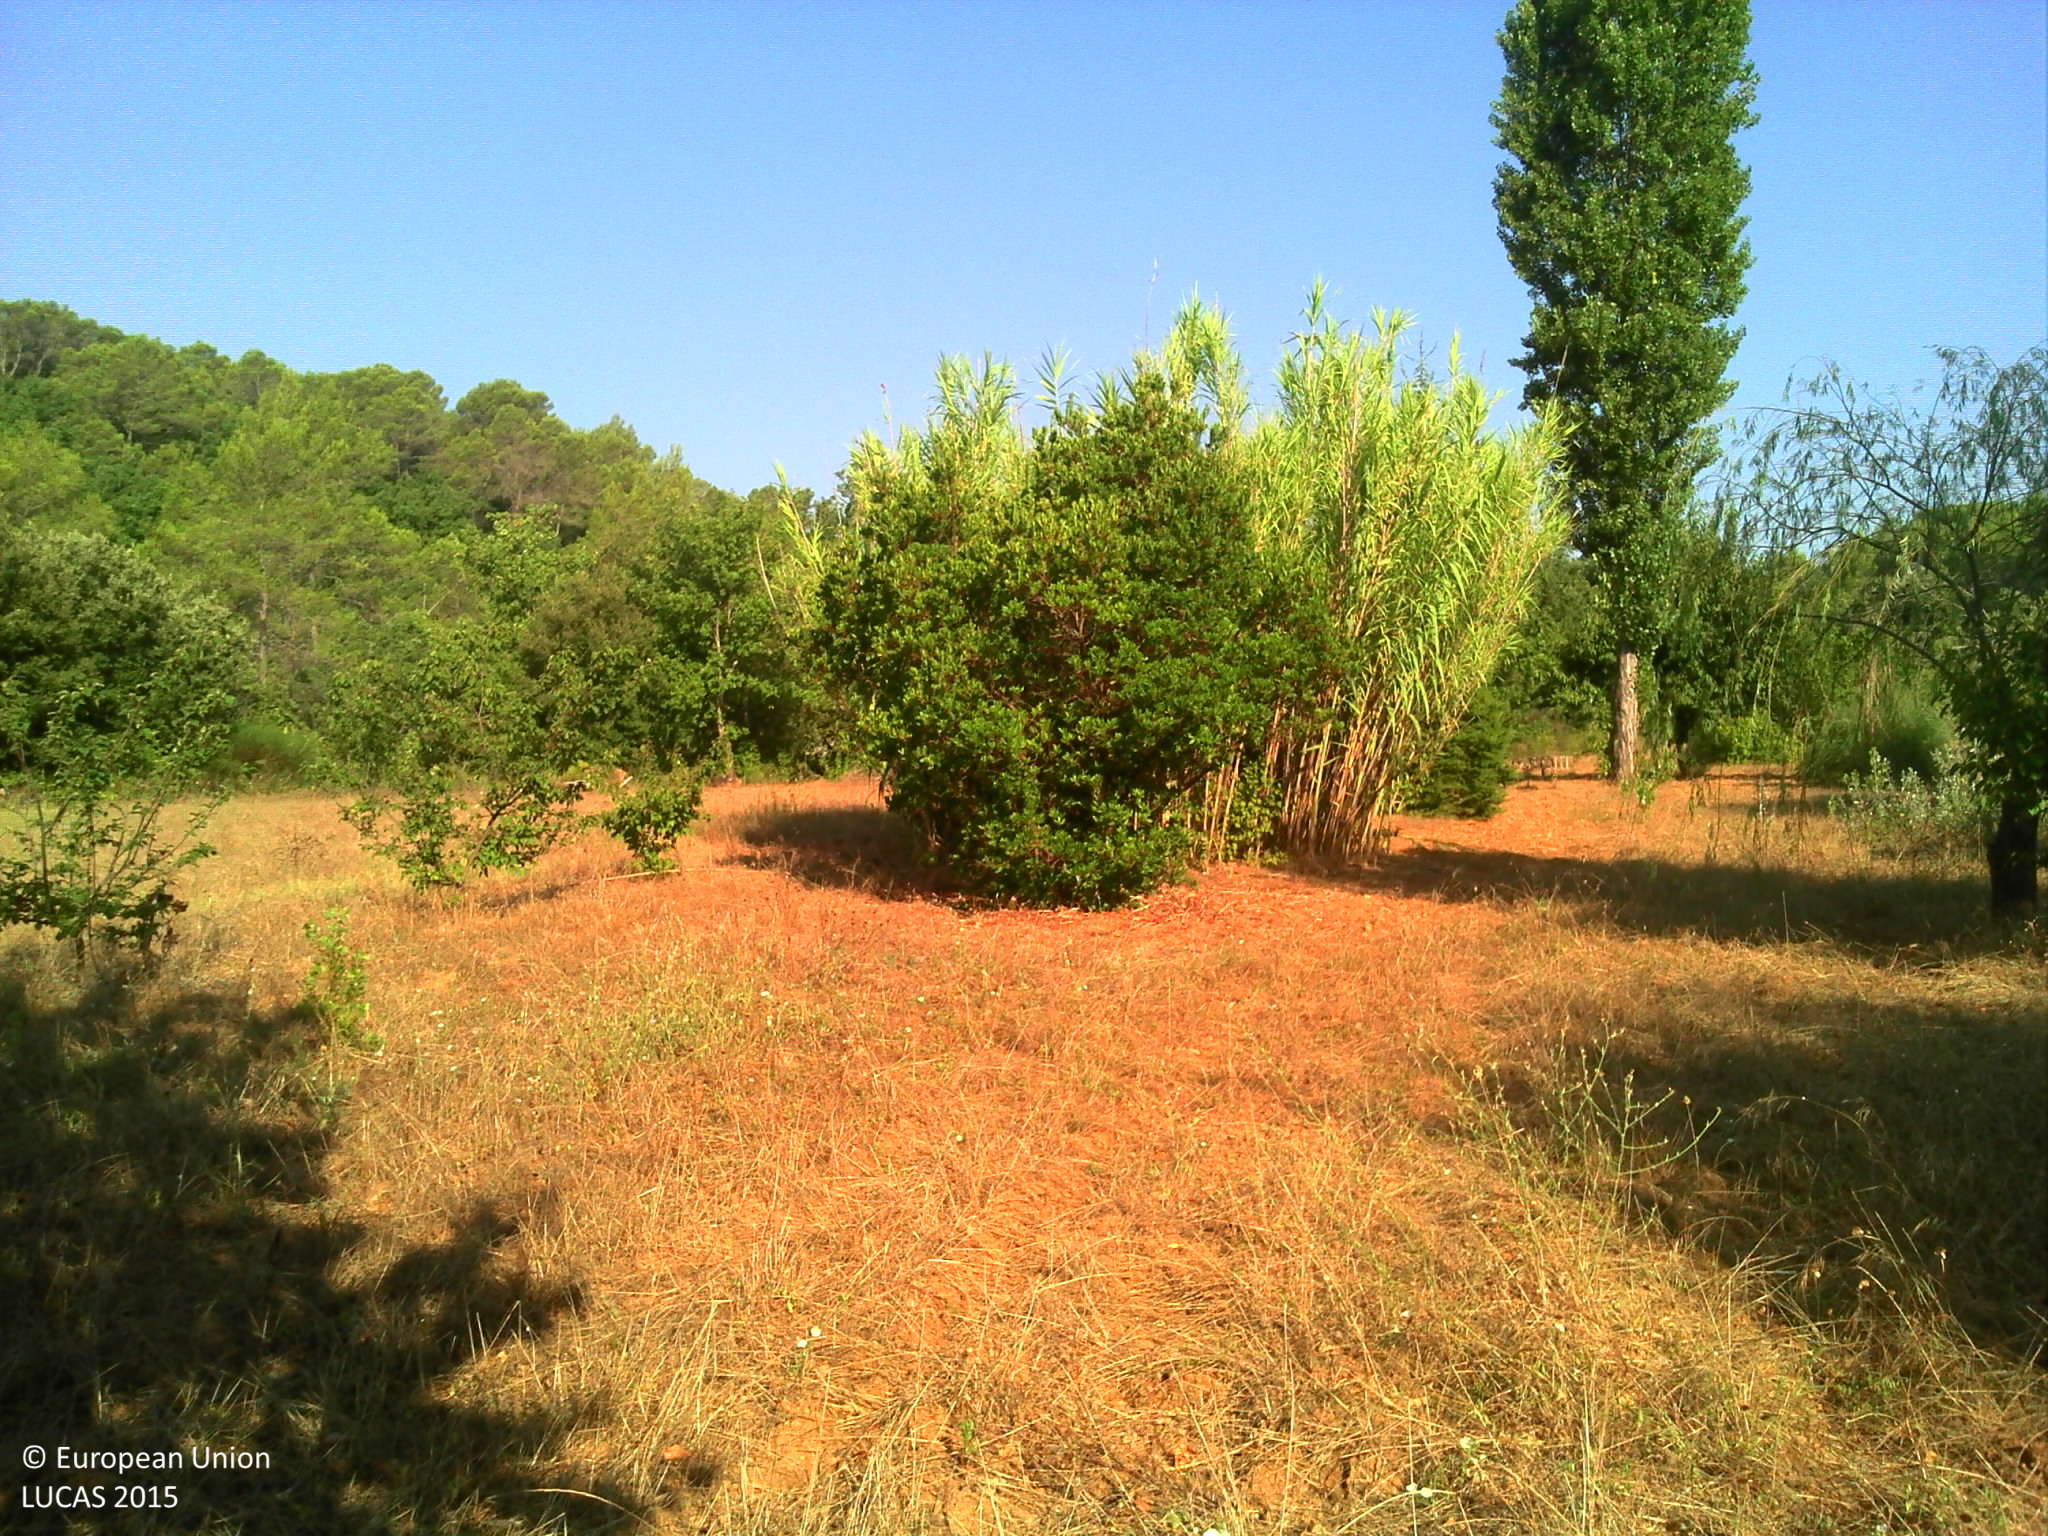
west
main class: Grassland
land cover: Grassland with sparse tree/shrub cover
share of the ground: > 75 %
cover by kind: herbaceous plants 95 %, broadleaved forest trees 5 %
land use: Residential
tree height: > 5 m
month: August
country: FR
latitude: 43.5111
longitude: 6.3843
